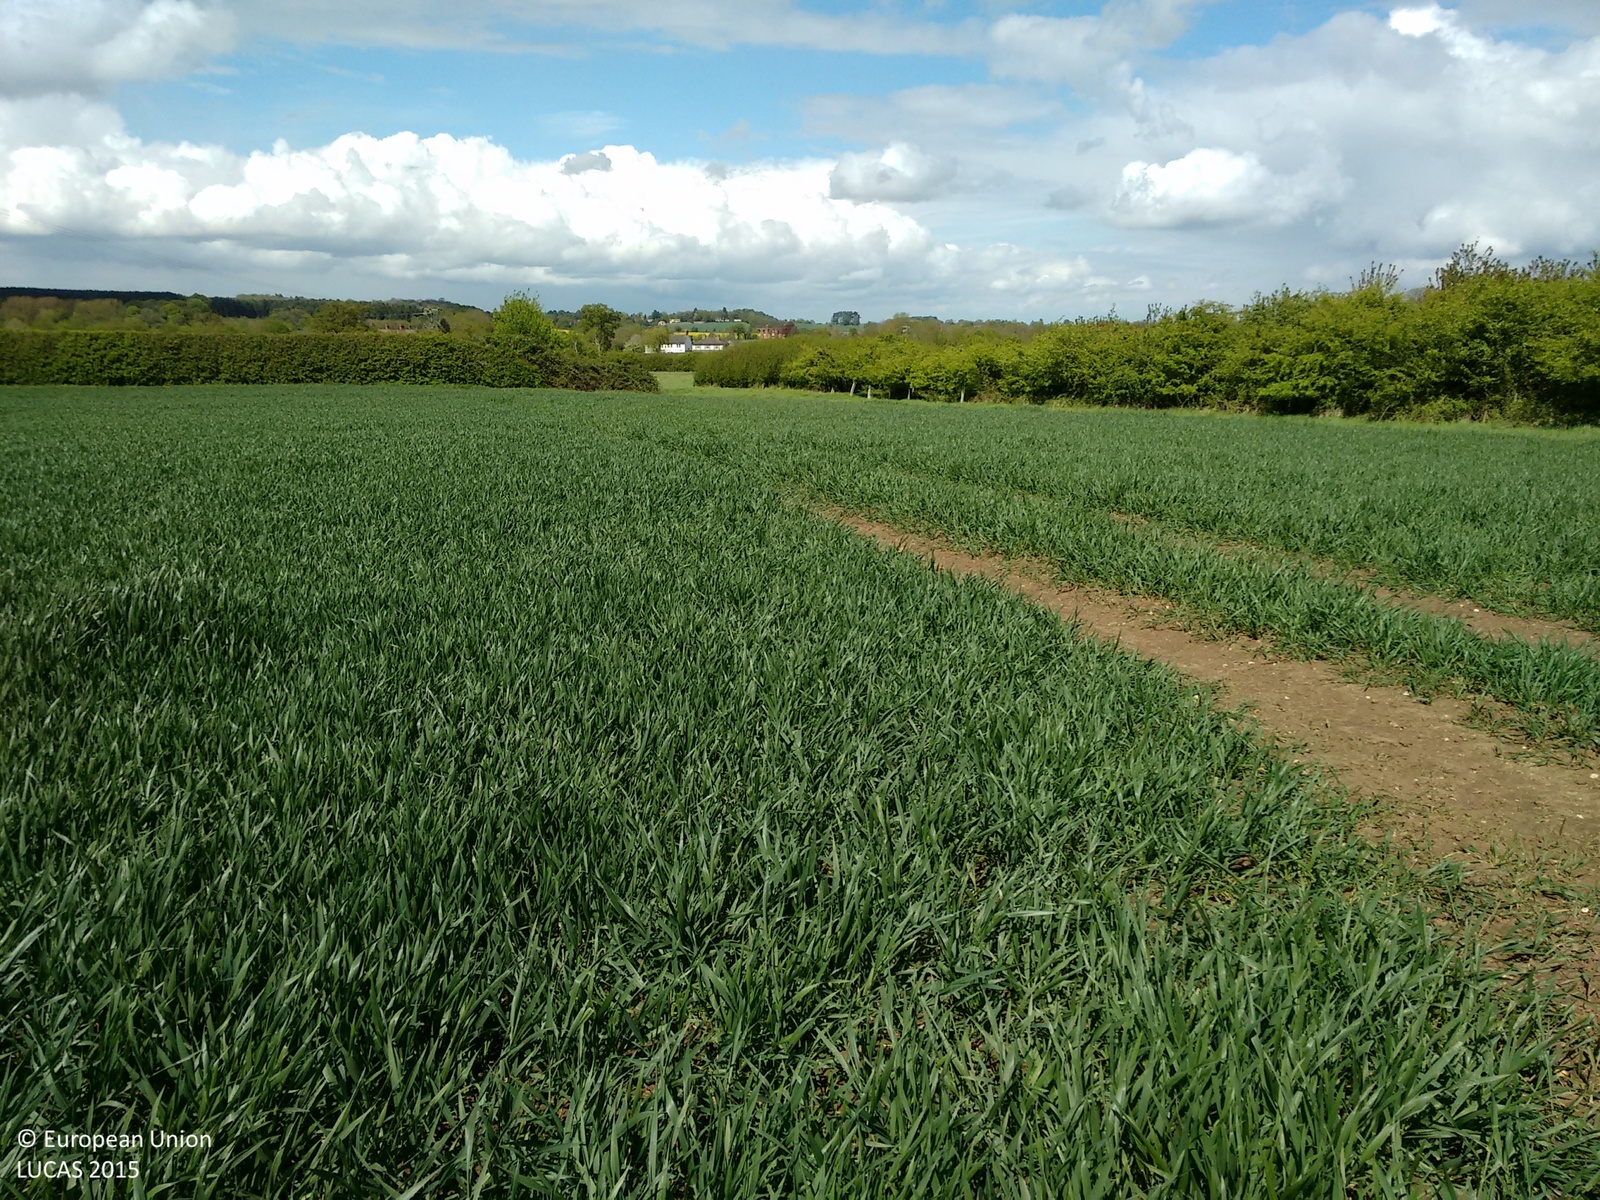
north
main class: Cropland
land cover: Common wheat
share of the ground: > 75 %
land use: Agriculture (excluding fallow land and kitchen gardens)
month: May
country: GB
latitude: 51.9897
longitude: -0.6267
